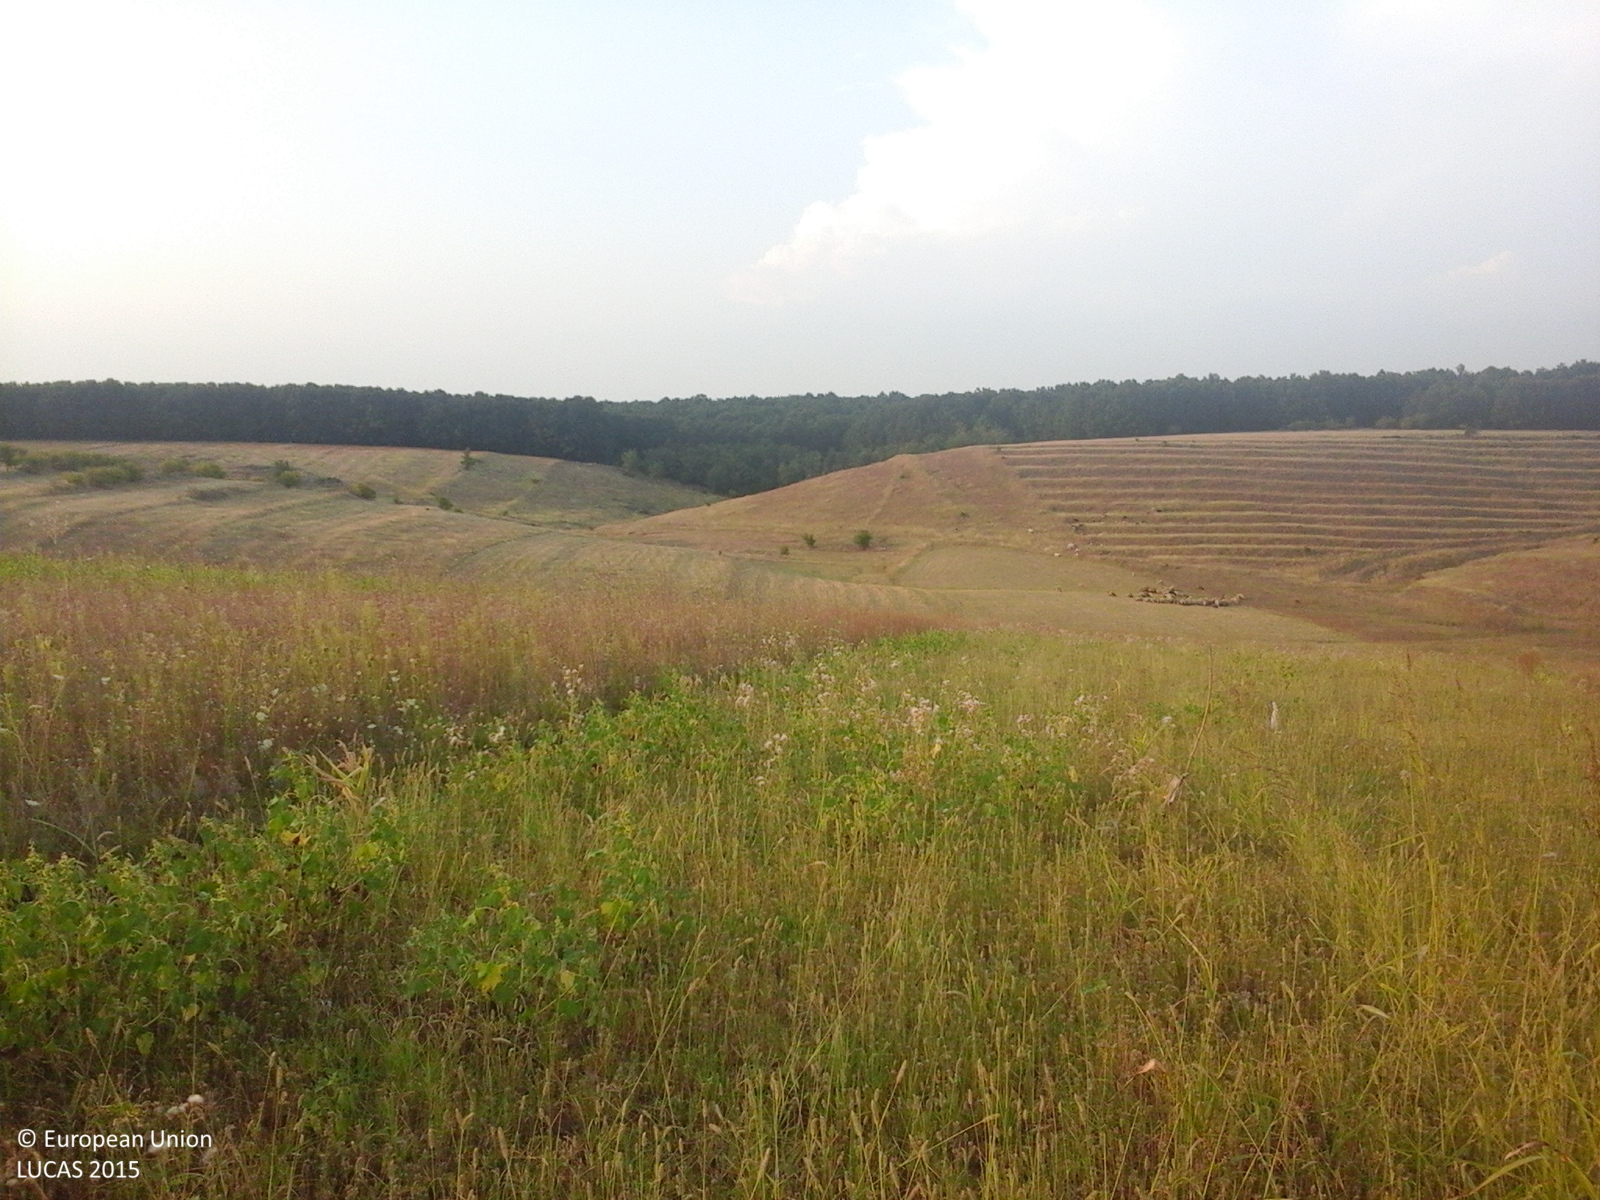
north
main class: Grassland
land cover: Spontaneously vegetated surfaces
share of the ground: > 75 %
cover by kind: herbaceous plants 100 %
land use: Fallow land
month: August
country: RO
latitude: 44.2311
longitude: 23.6370
